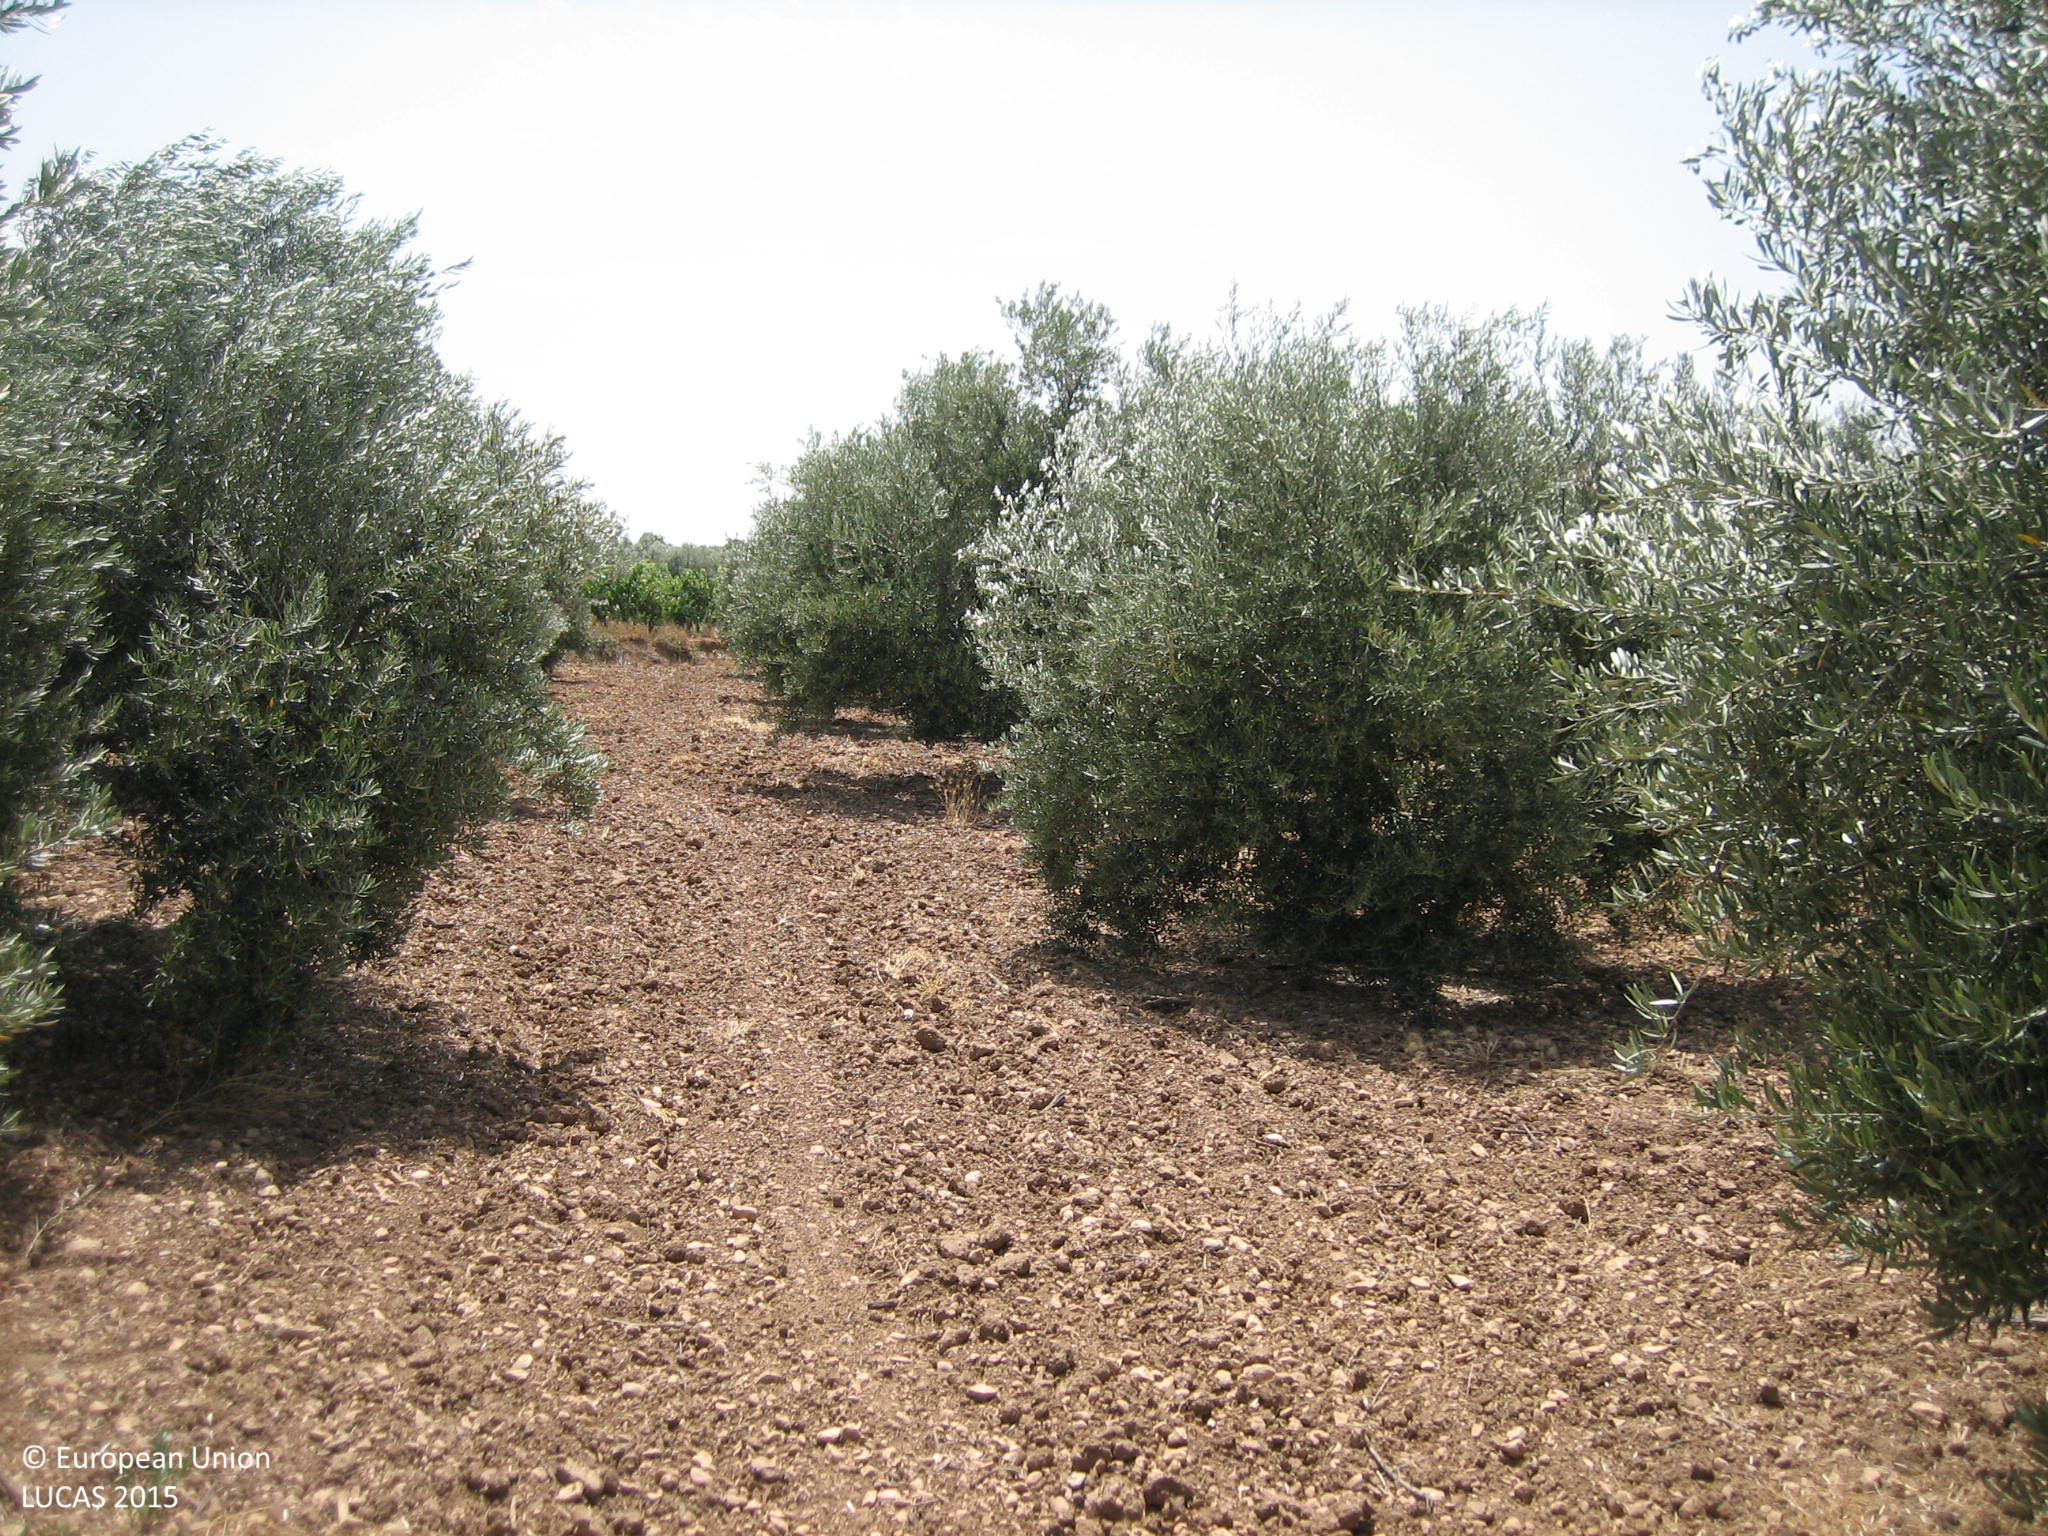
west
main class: Cropland
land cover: Olive groves
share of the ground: 10 - 25 %
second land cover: Other bare soil
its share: > 75 %
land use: Agriculture (excluding fallow land and kitchen gardens)
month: July
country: ES
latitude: 37.6621
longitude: -2.9710
